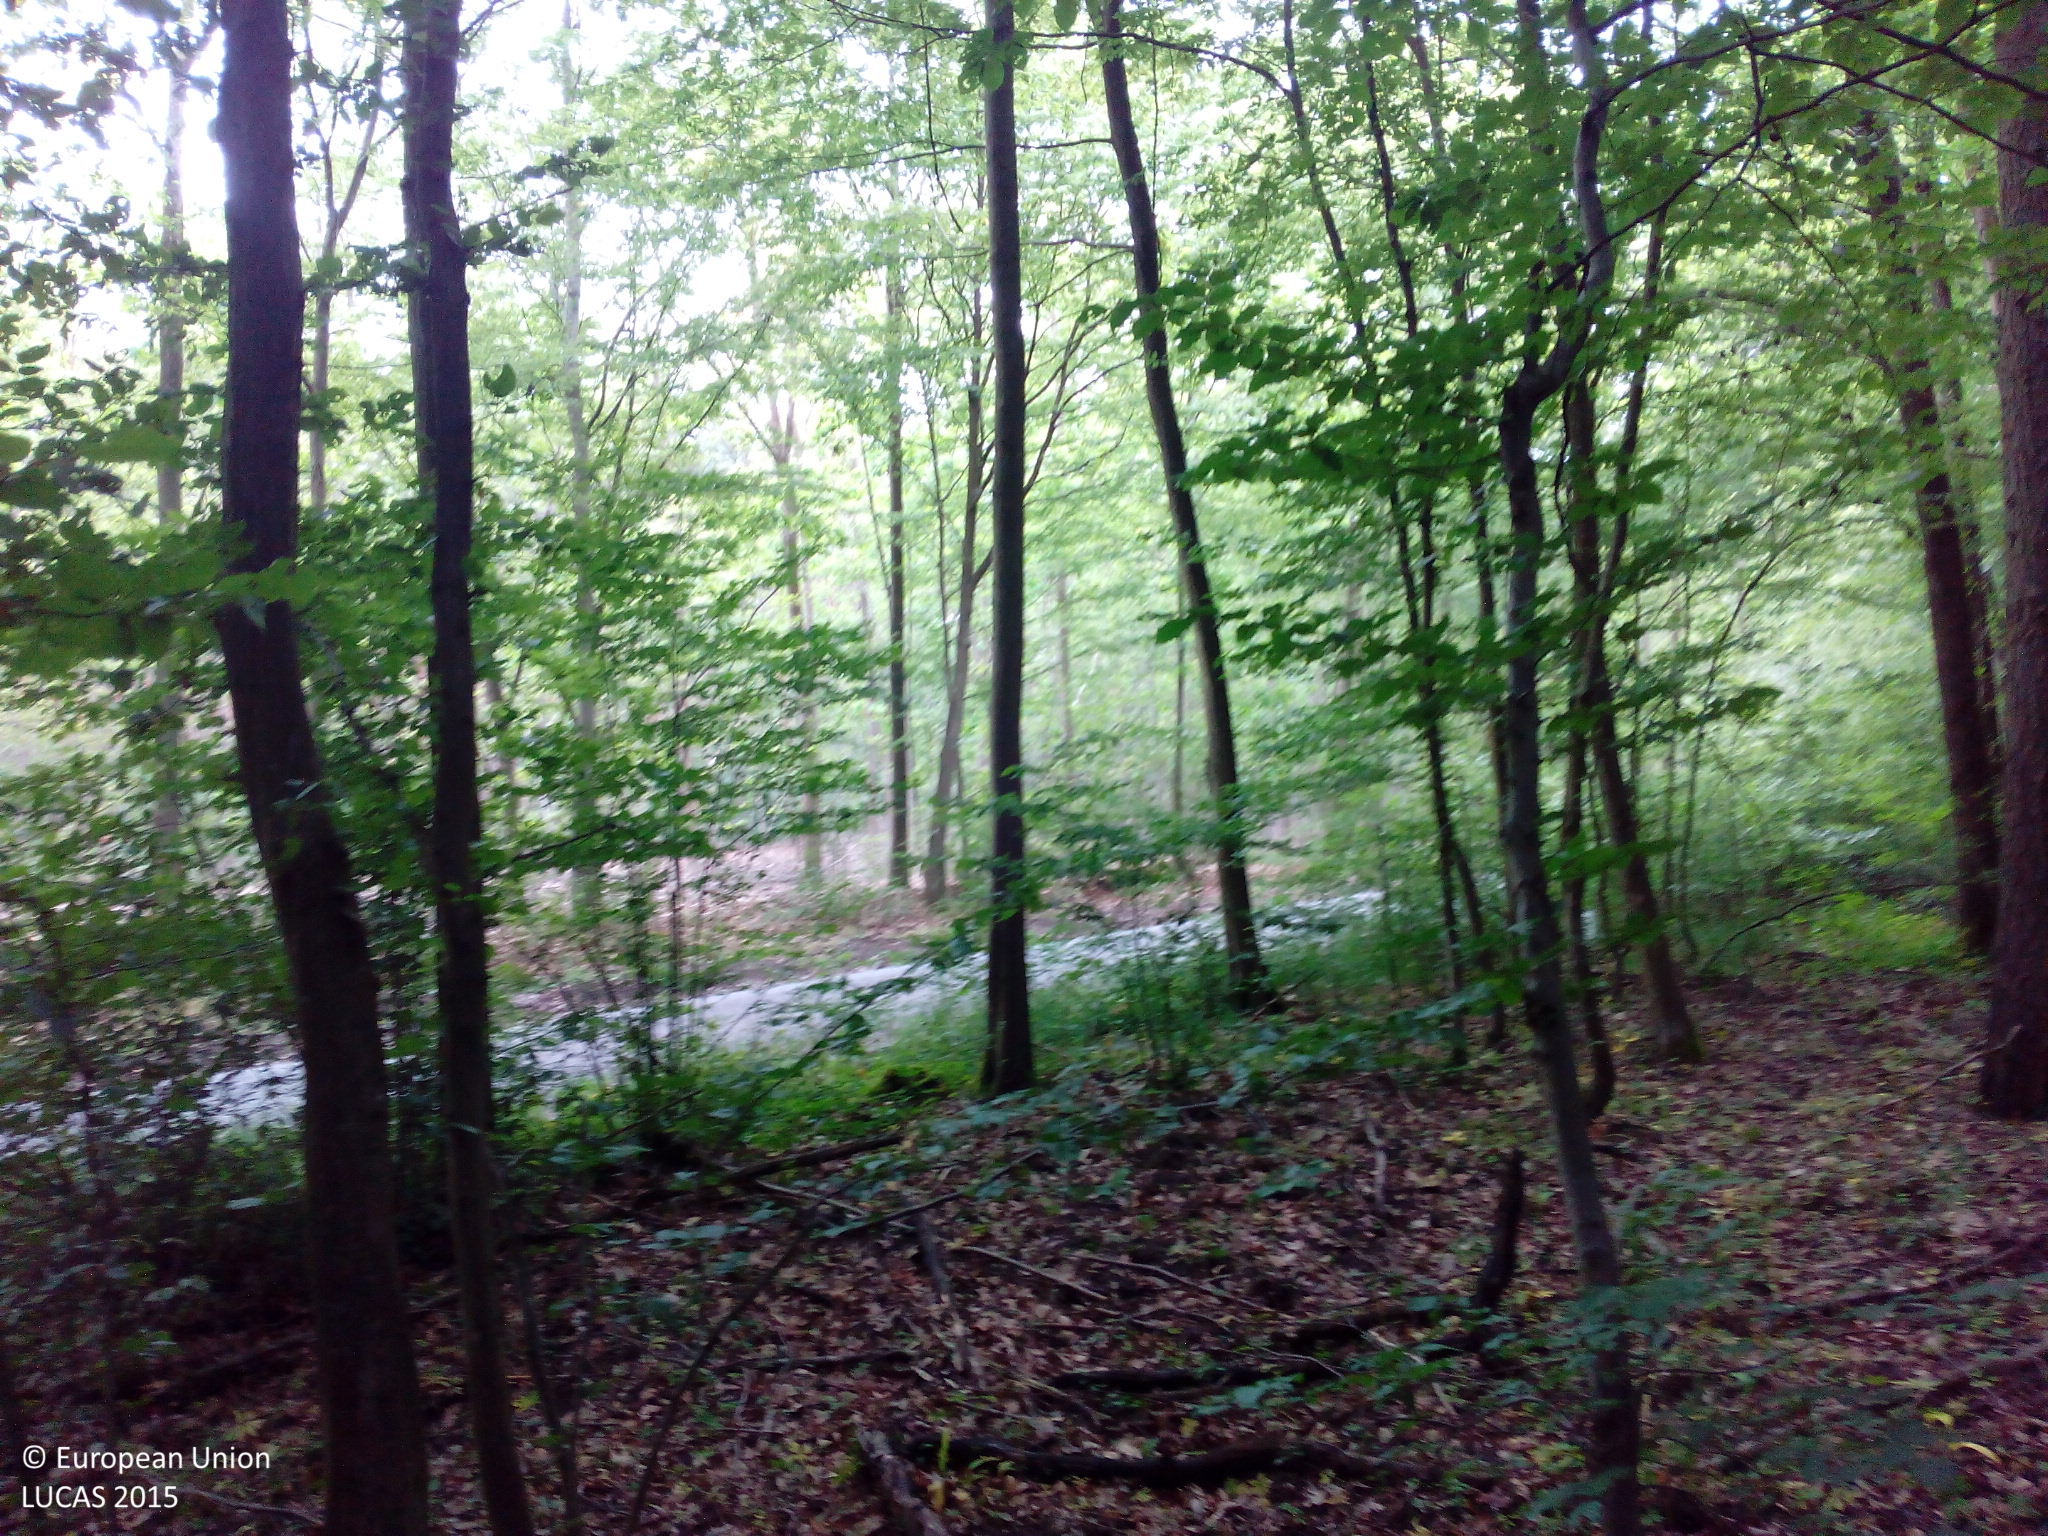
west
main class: Woodland
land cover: Broadleaved woodland
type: beech forest
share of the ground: > 75 %
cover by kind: broadleaved forest trees 90 %, herbaceous plants 5 %, unconsolidated bare surface 5 %
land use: Forestry
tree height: > 5 m
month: June
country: DE
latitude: 49.2218
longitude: 8.5589
